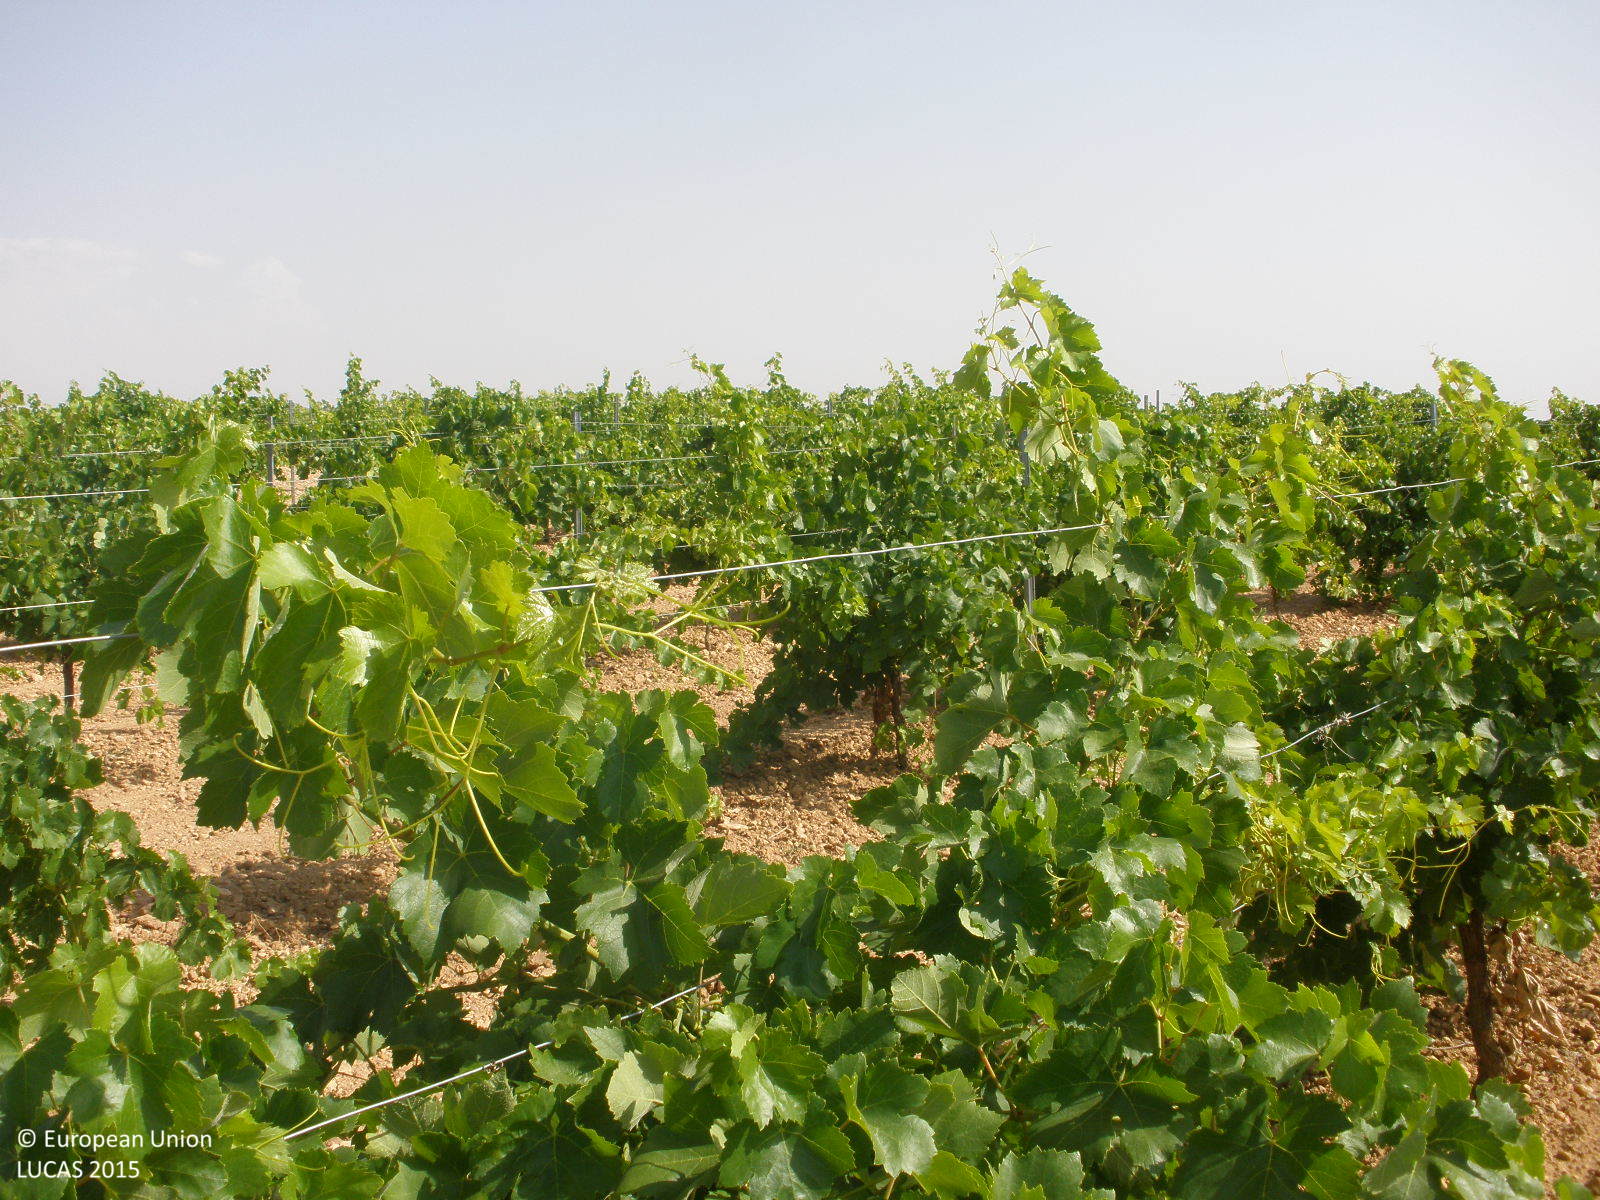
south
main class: Cropland
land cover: Vineyards
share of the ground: 25 - 50 %
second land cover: Other bare soil
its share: > 75 %
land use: Agriculture (excluding fallow land and kitchen gardens)
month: July
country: ES
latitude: 39.6928
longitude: -3.2579
